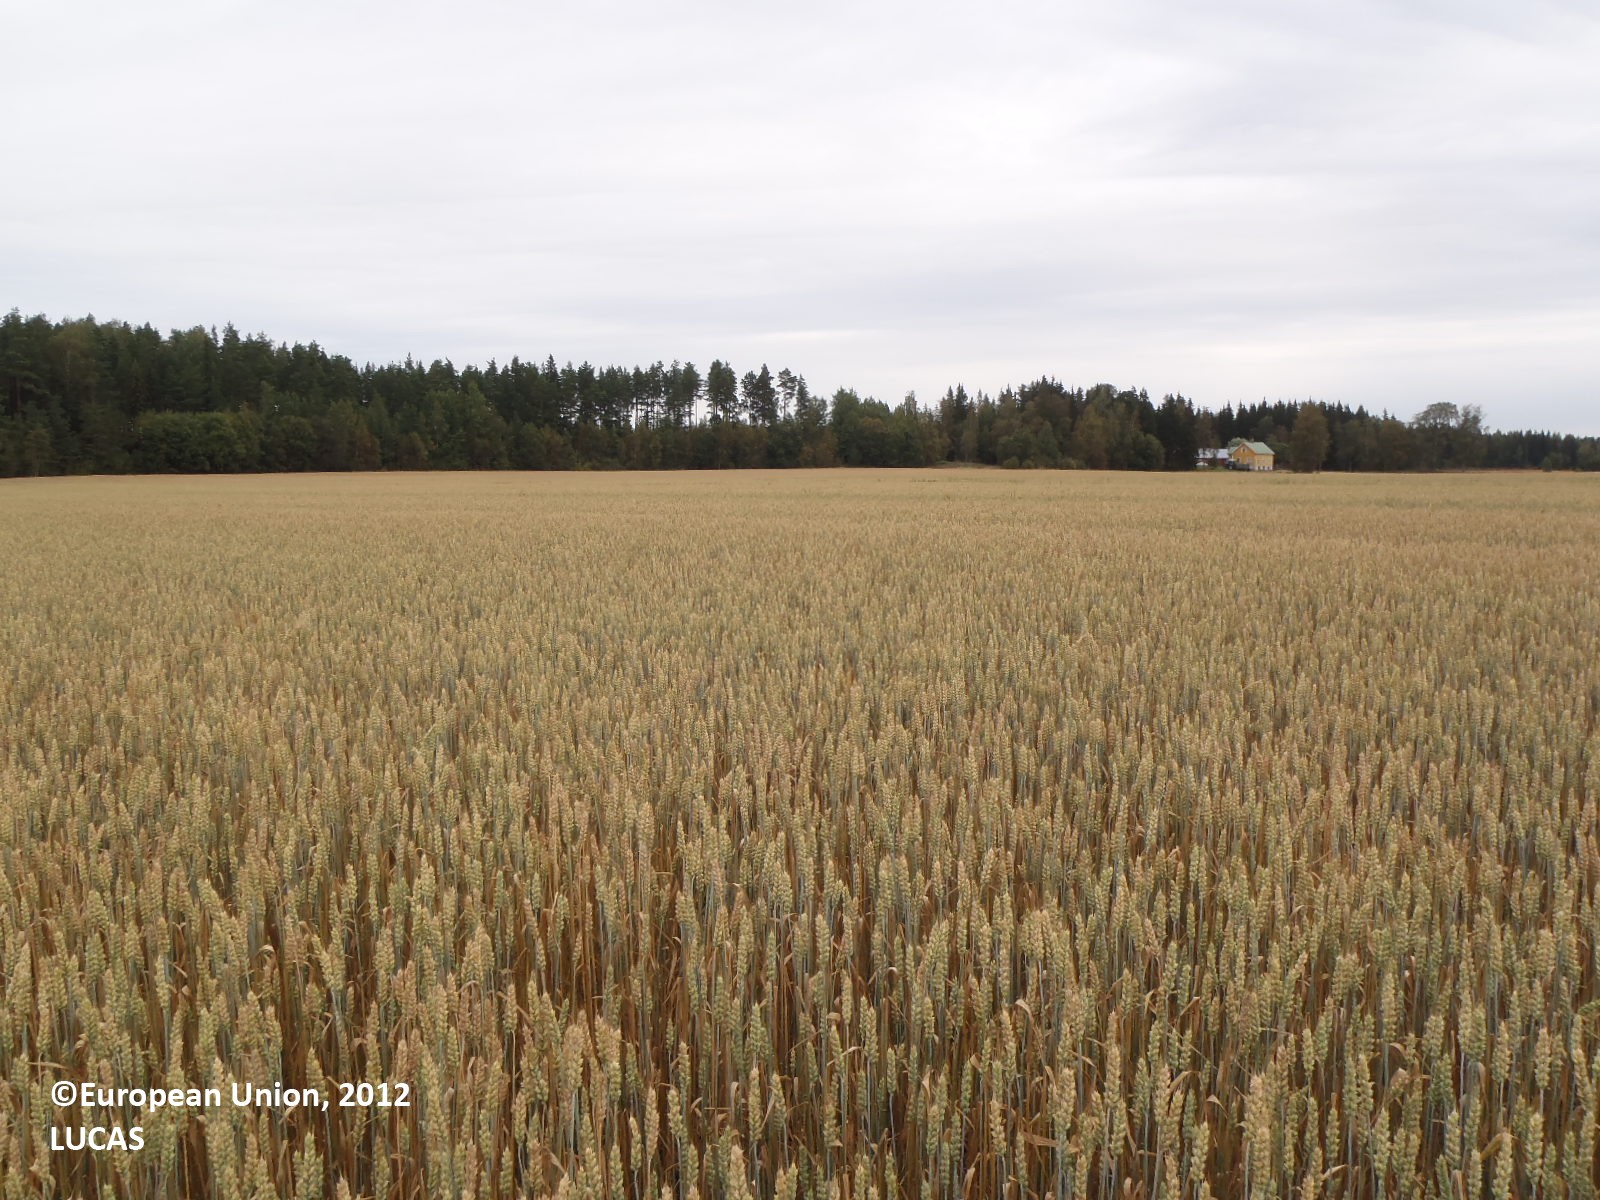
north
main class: Cropland
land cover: Common wheat
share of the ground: > 75 %
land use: Agriculture (excluding fallow land and kitchen gardens)
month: August
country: FI
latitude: 60.8697
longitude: 21.7887
